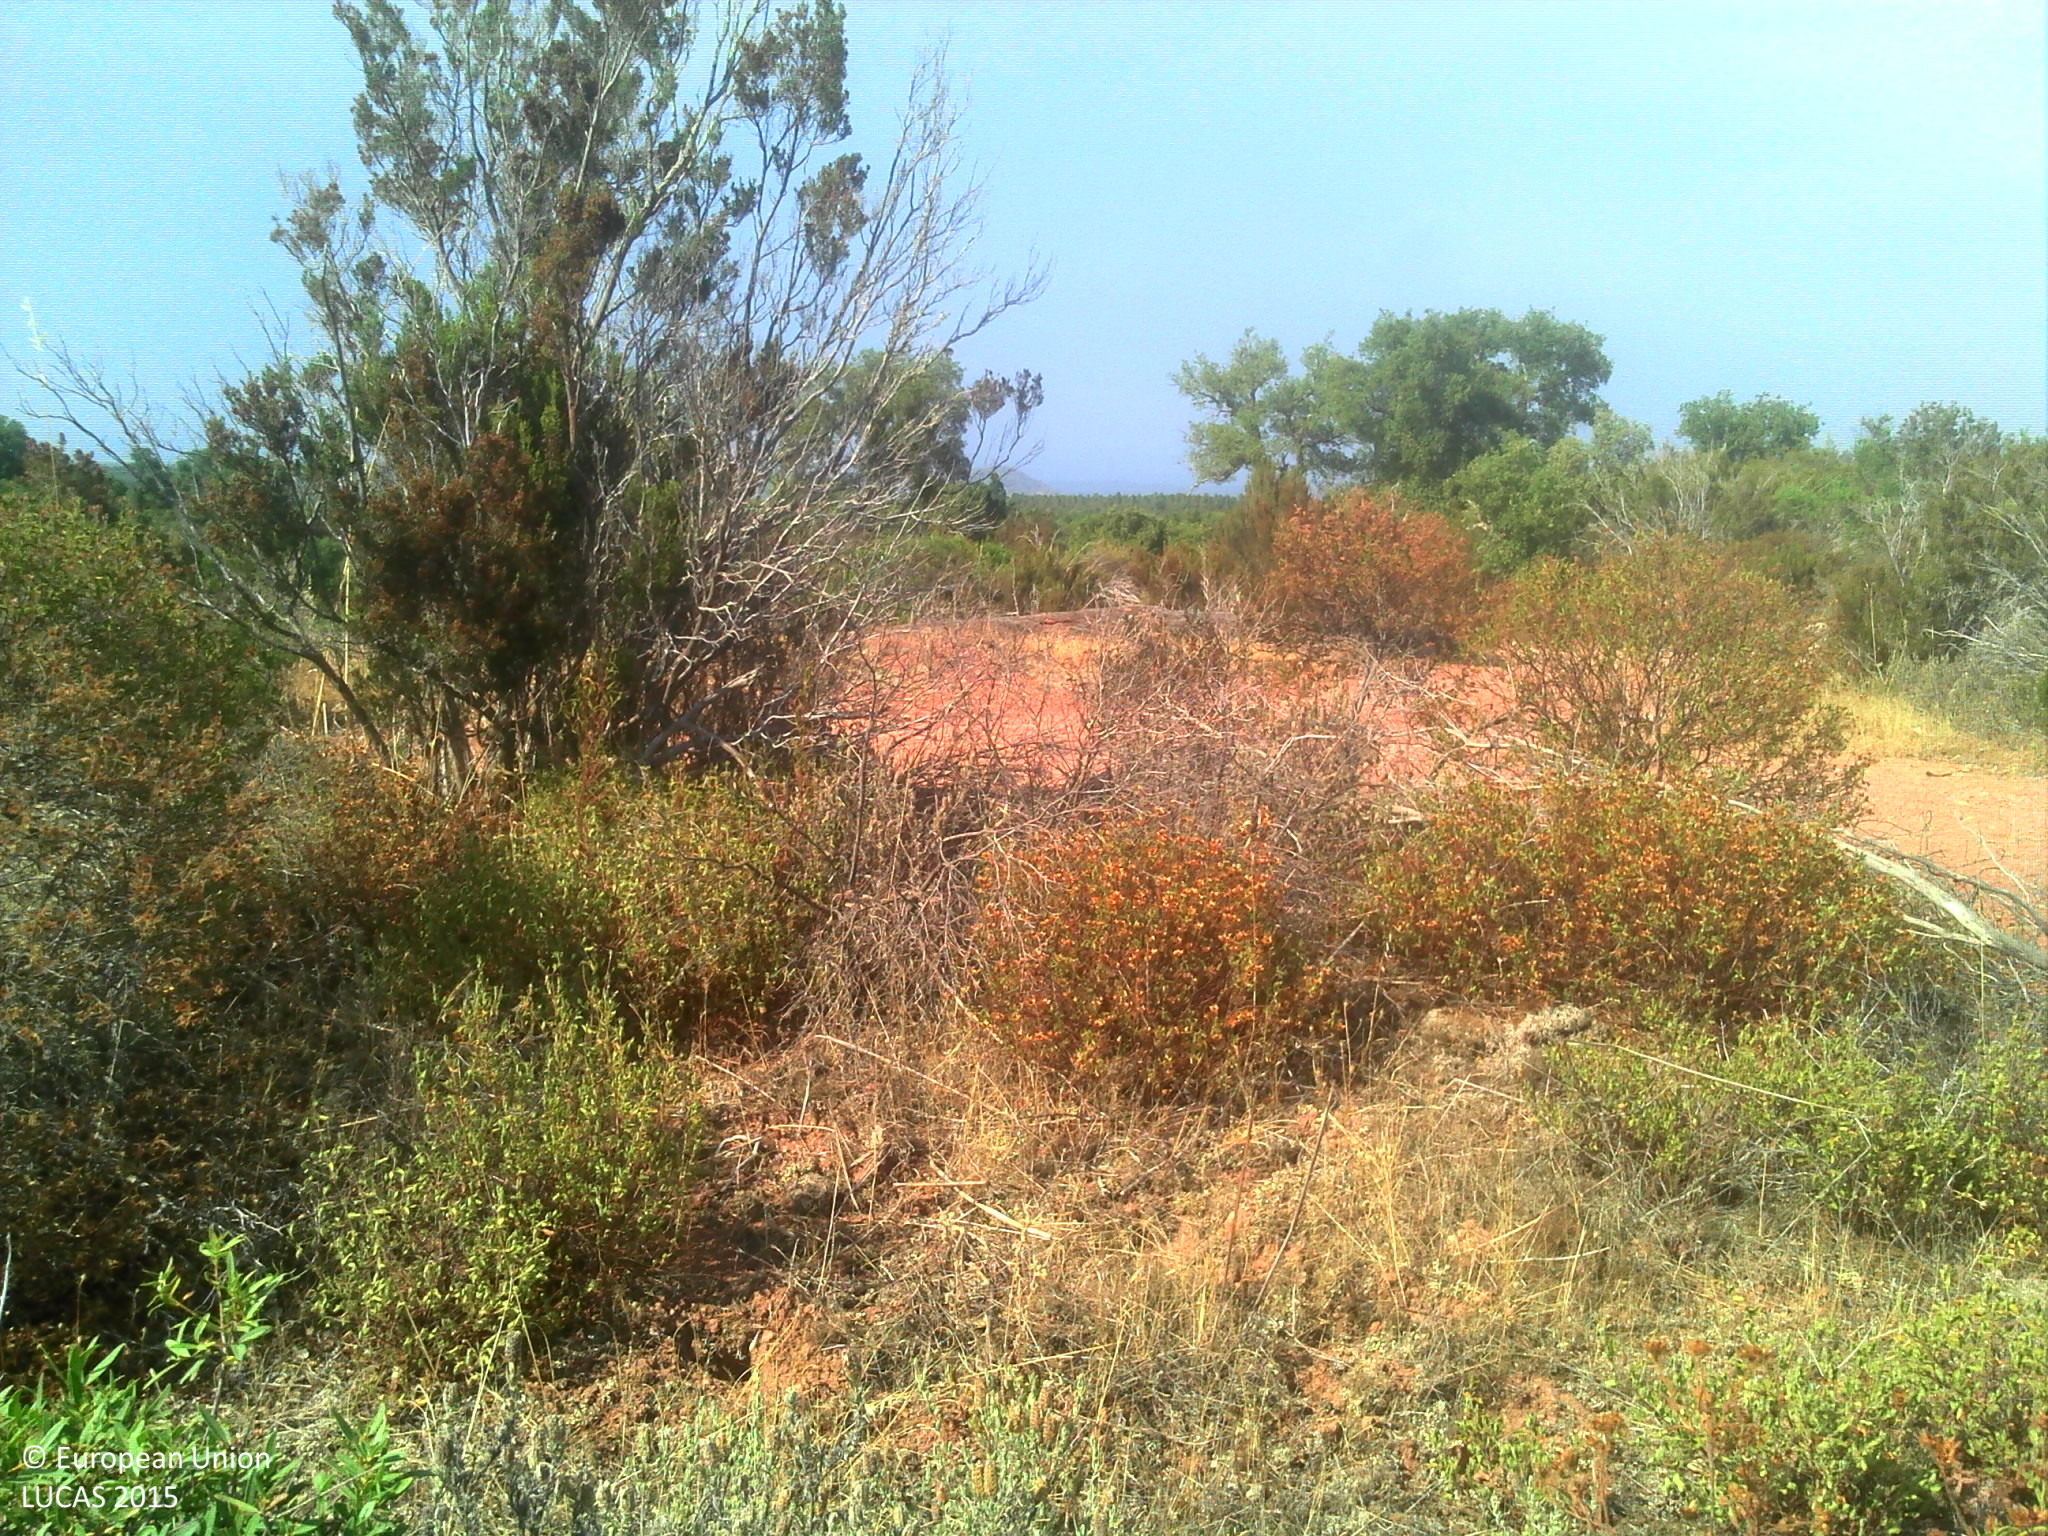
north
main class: Shrubland
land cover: Shrubland without tree cover
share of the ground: > 75 %
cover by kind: shrubs 100 %
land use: Semi-natural and natural areas not in use
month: July
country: FR
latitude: 43.3300
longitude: 6.3709
